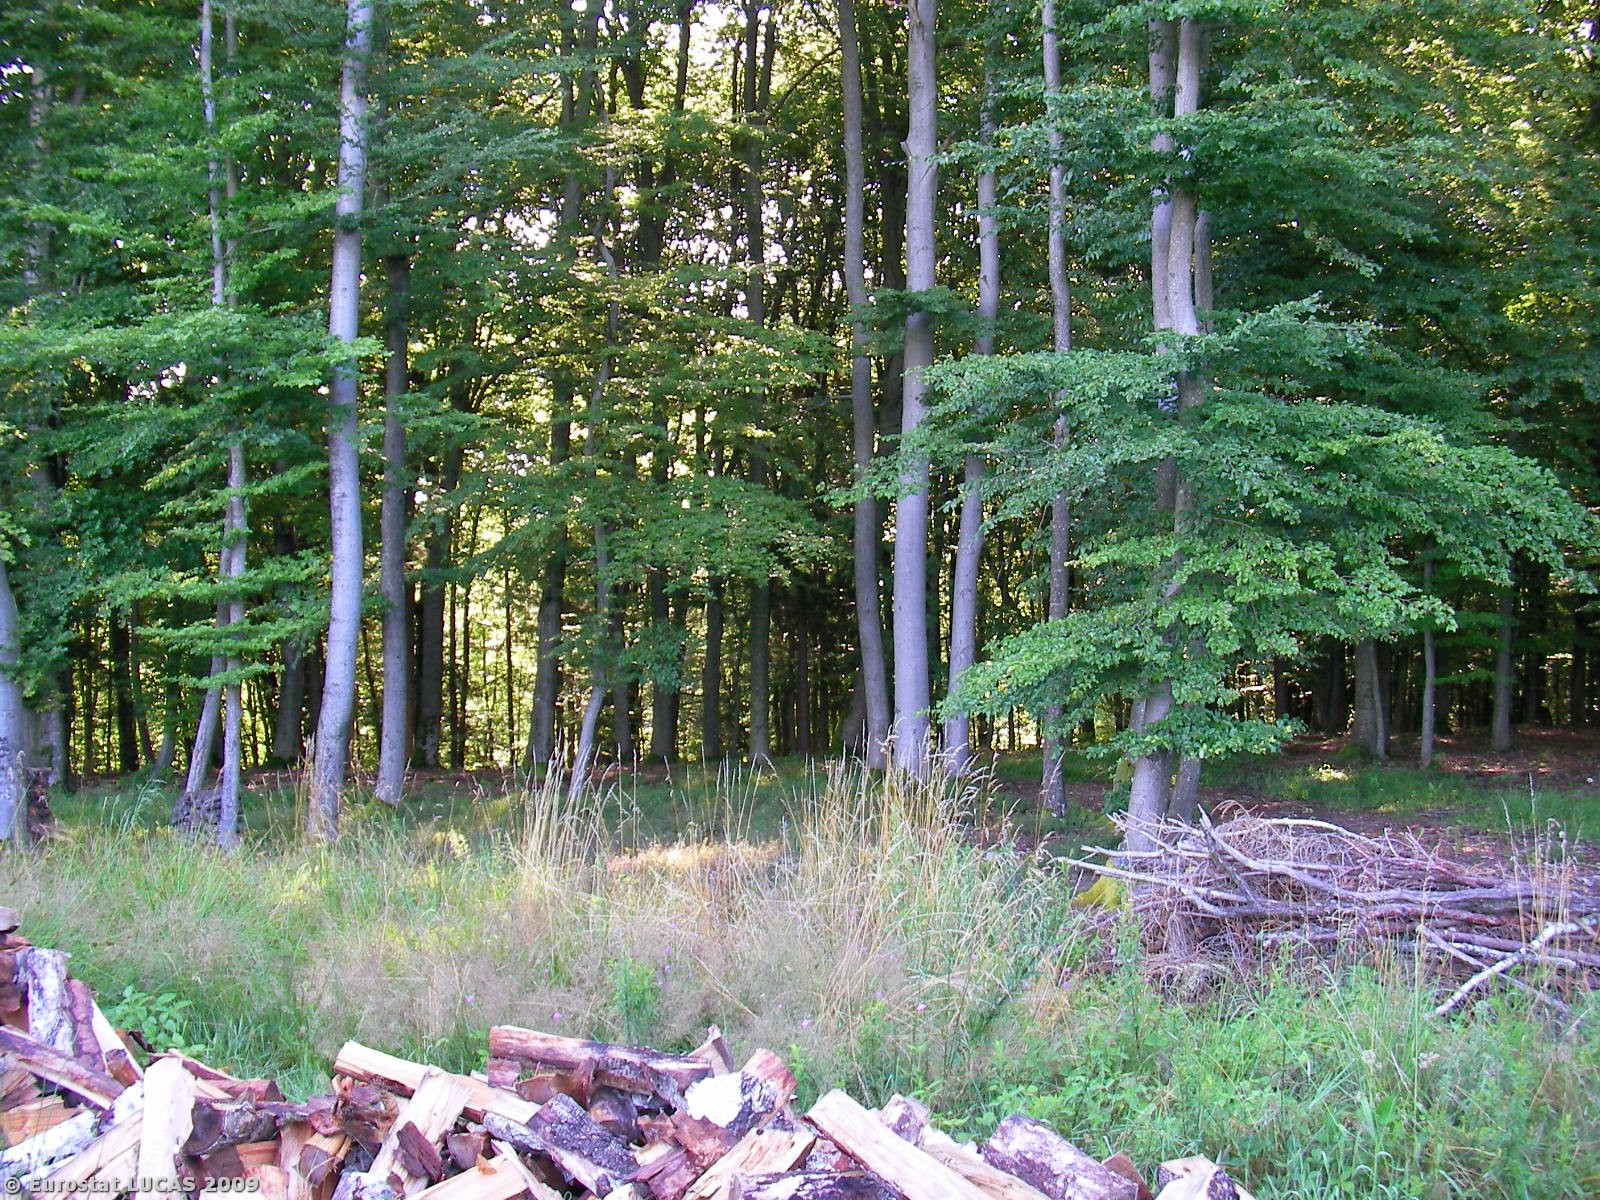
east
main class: Cropland
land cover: Maize
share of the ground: > 75 %
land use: Agriculture (excluding fallow land and kitchen gardens)
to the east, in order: Maize; Grassland without tree/shrub cover; Broadleaved woodland; Rivers and streams; Mixed woodland
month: July
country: AT
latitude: 46.9565
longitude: 15.7163
